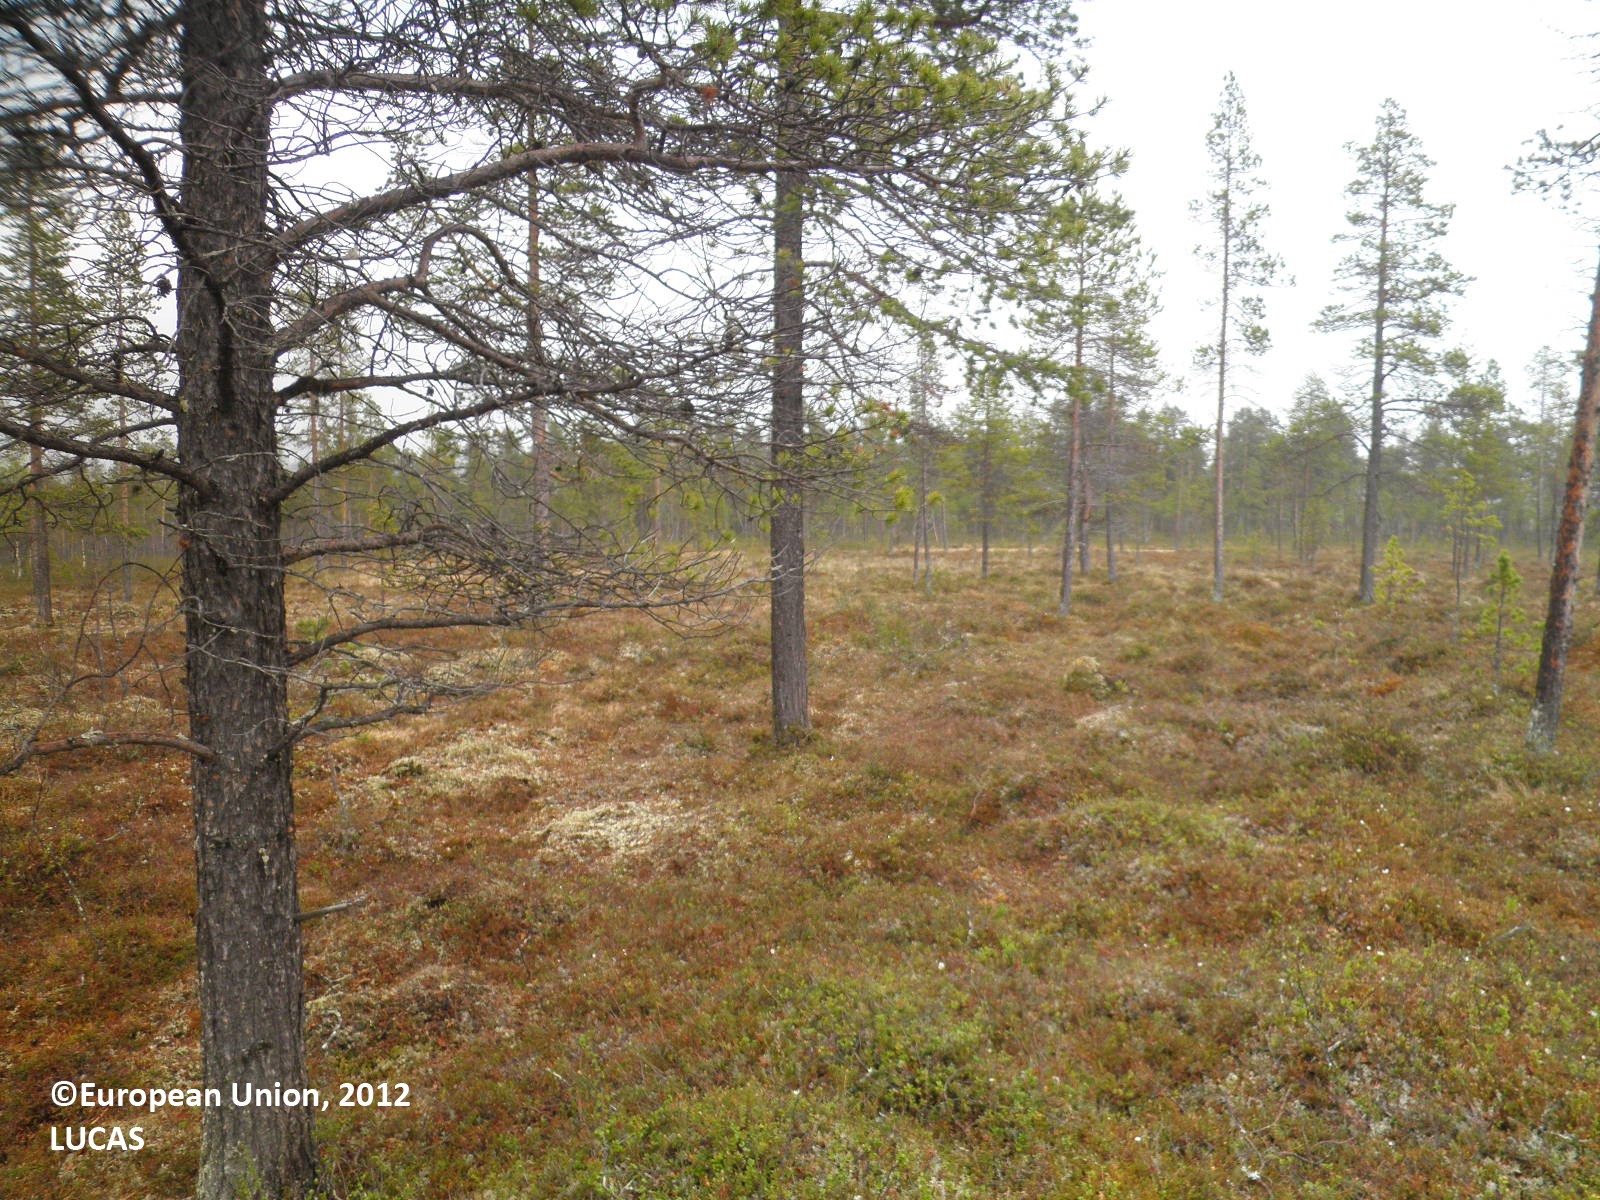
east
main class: Woodland
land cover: Pine dominated coniferous woodland
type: boreal forest
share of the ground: 25 - 50 %
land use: Forestry
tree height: > 5 m
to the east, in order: Pine dominated coniferous woodland; Ditches and canals; Pine dominated mixed woodland
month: June
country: FI
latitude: 68.9019
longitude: 26.5016
